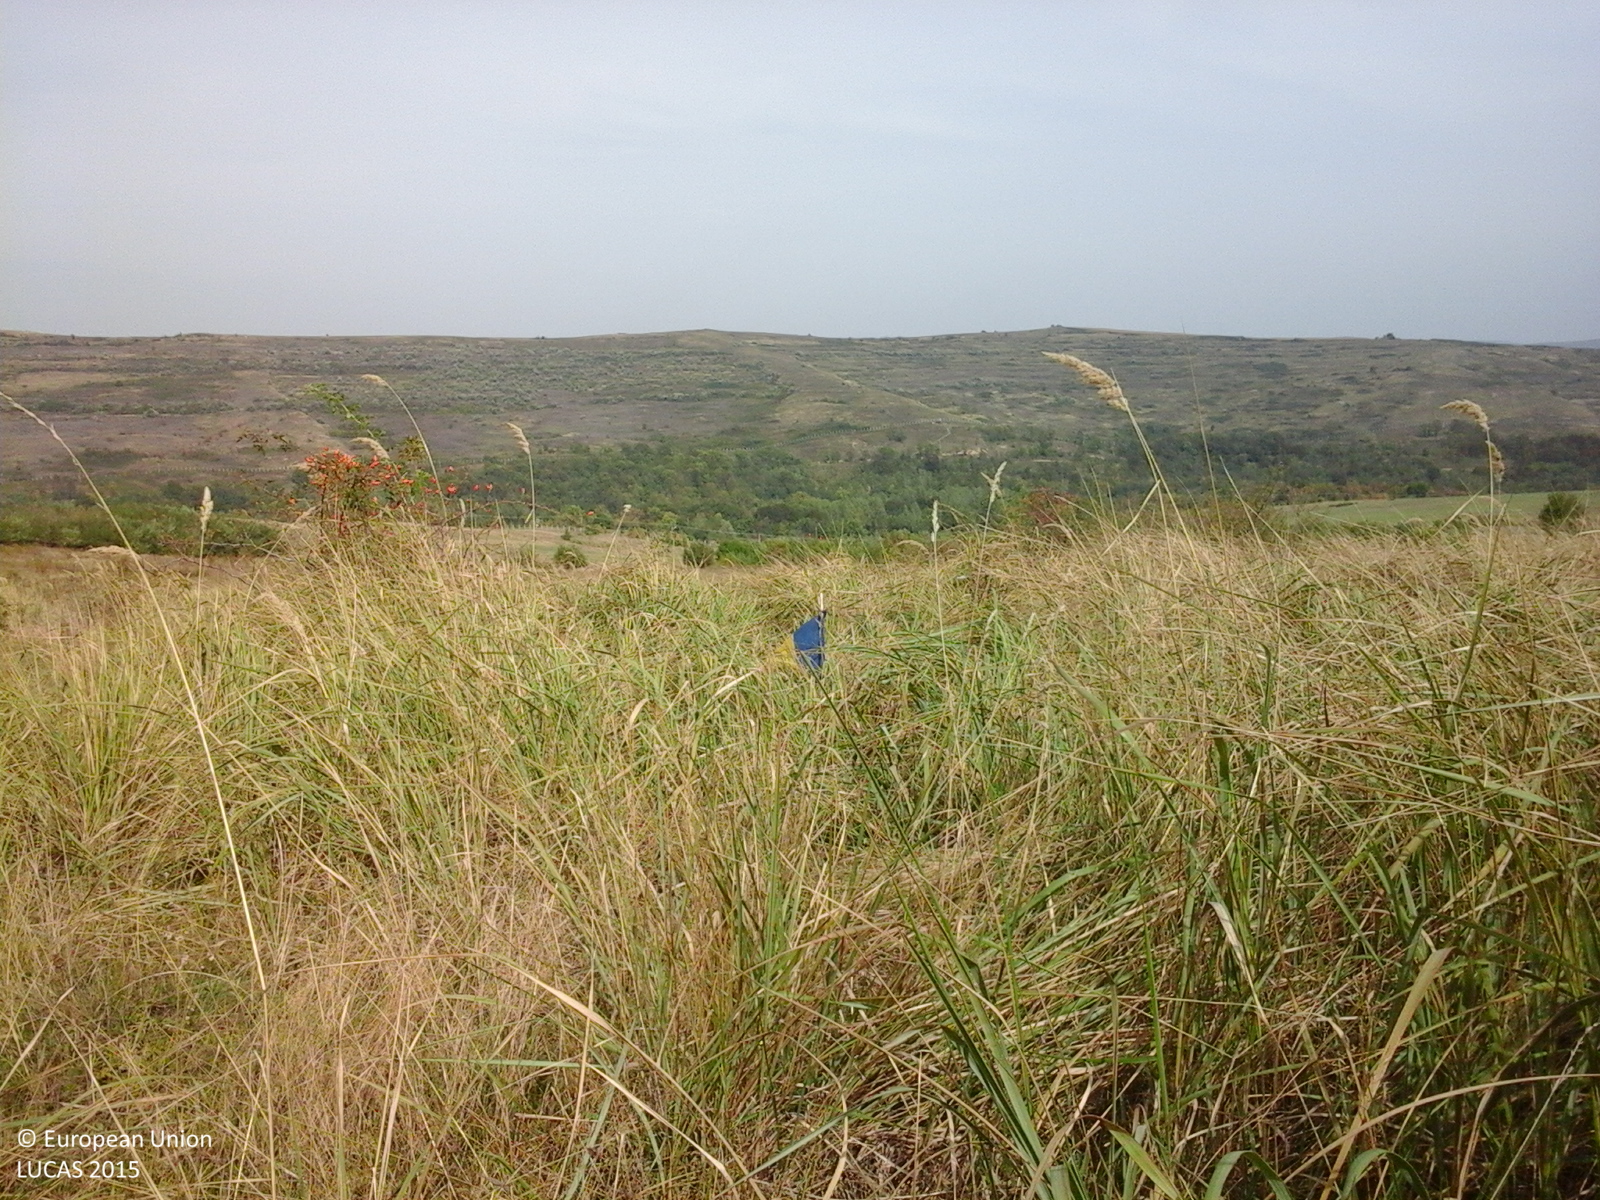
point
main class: Grassland
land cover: Grassland with sparse tree/shrub cover
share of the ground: > 75 %
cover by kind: herbaceous plants 85 %, shrubs 10 %, broadleaved forest trees 5 %
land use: Agriculture (excluding fallow land and kitchen gardens)
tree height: < 5 m
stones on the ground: < 10 %
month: September
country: RO
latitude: 46.8665
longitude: 23.7306
